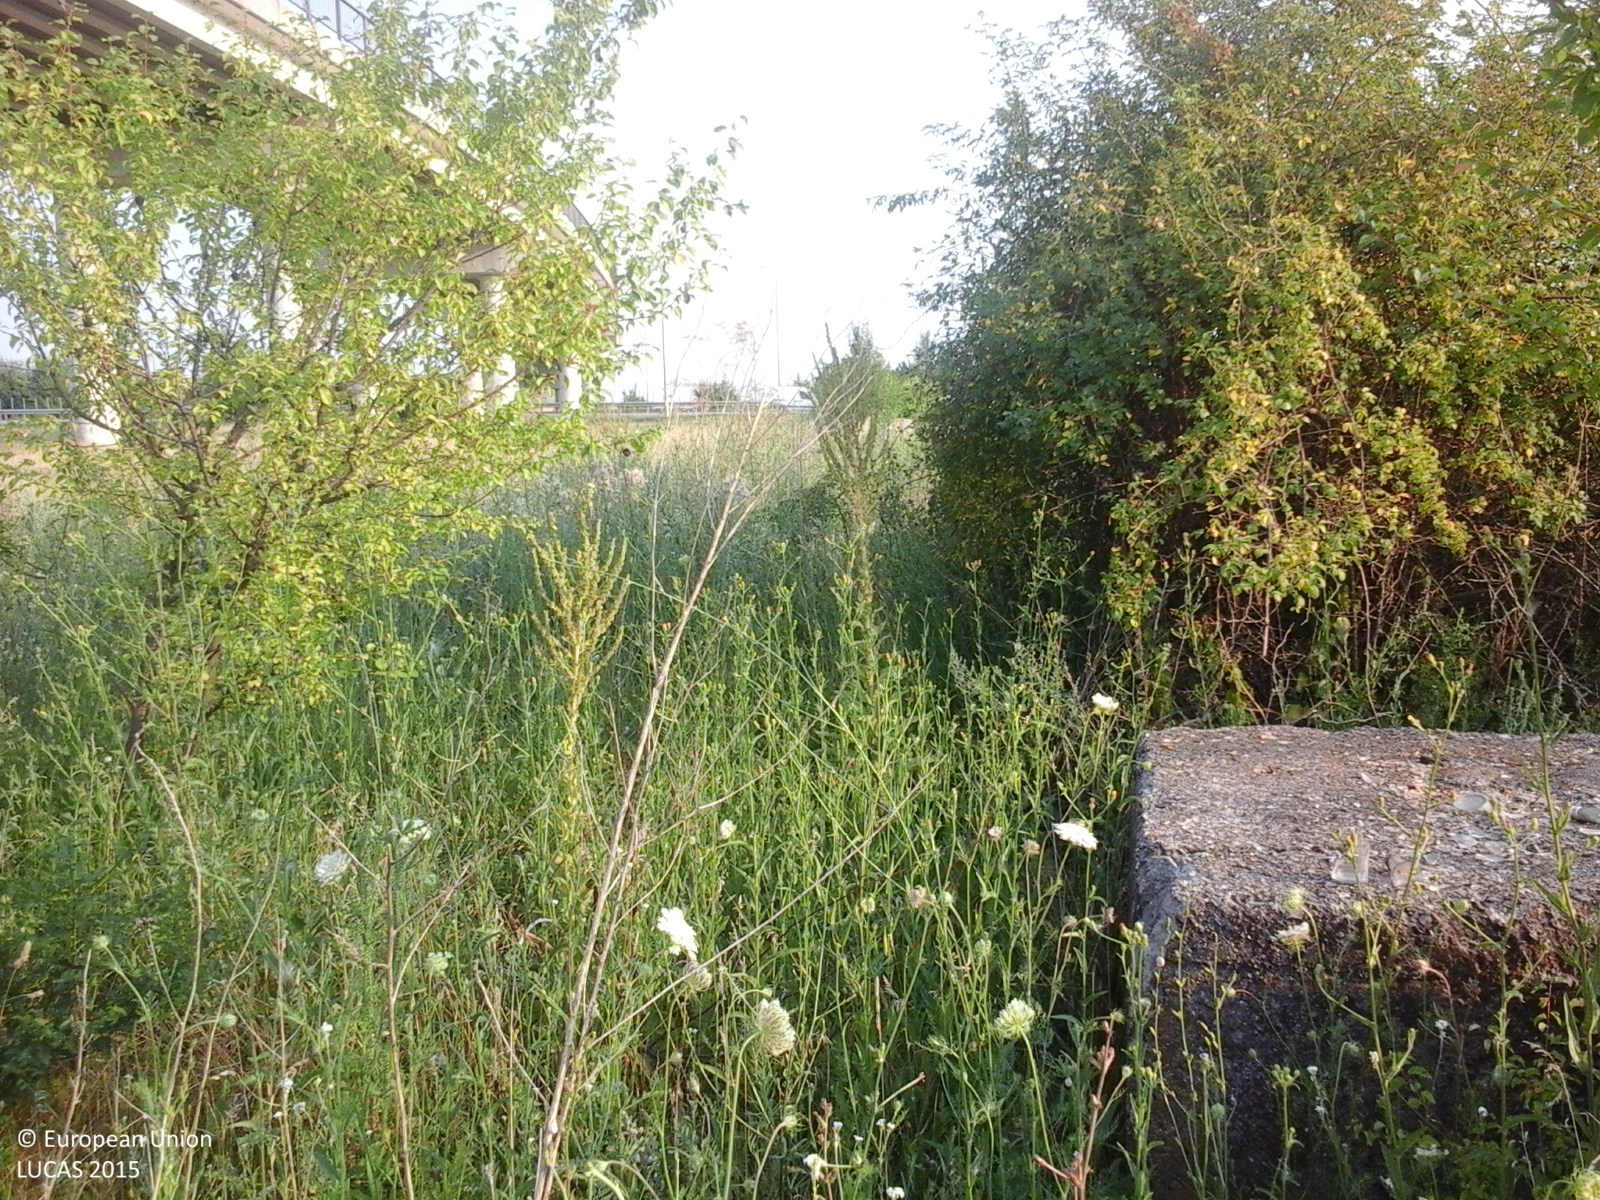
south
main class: Grassland
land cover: Spontaneously vegetated surfaces
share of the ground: > 75 %
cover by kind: herbaceous plants 100 %
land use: Semi-natural and natural areas not in use
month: July
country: RO
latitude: 44.4498
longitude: 26.5144
